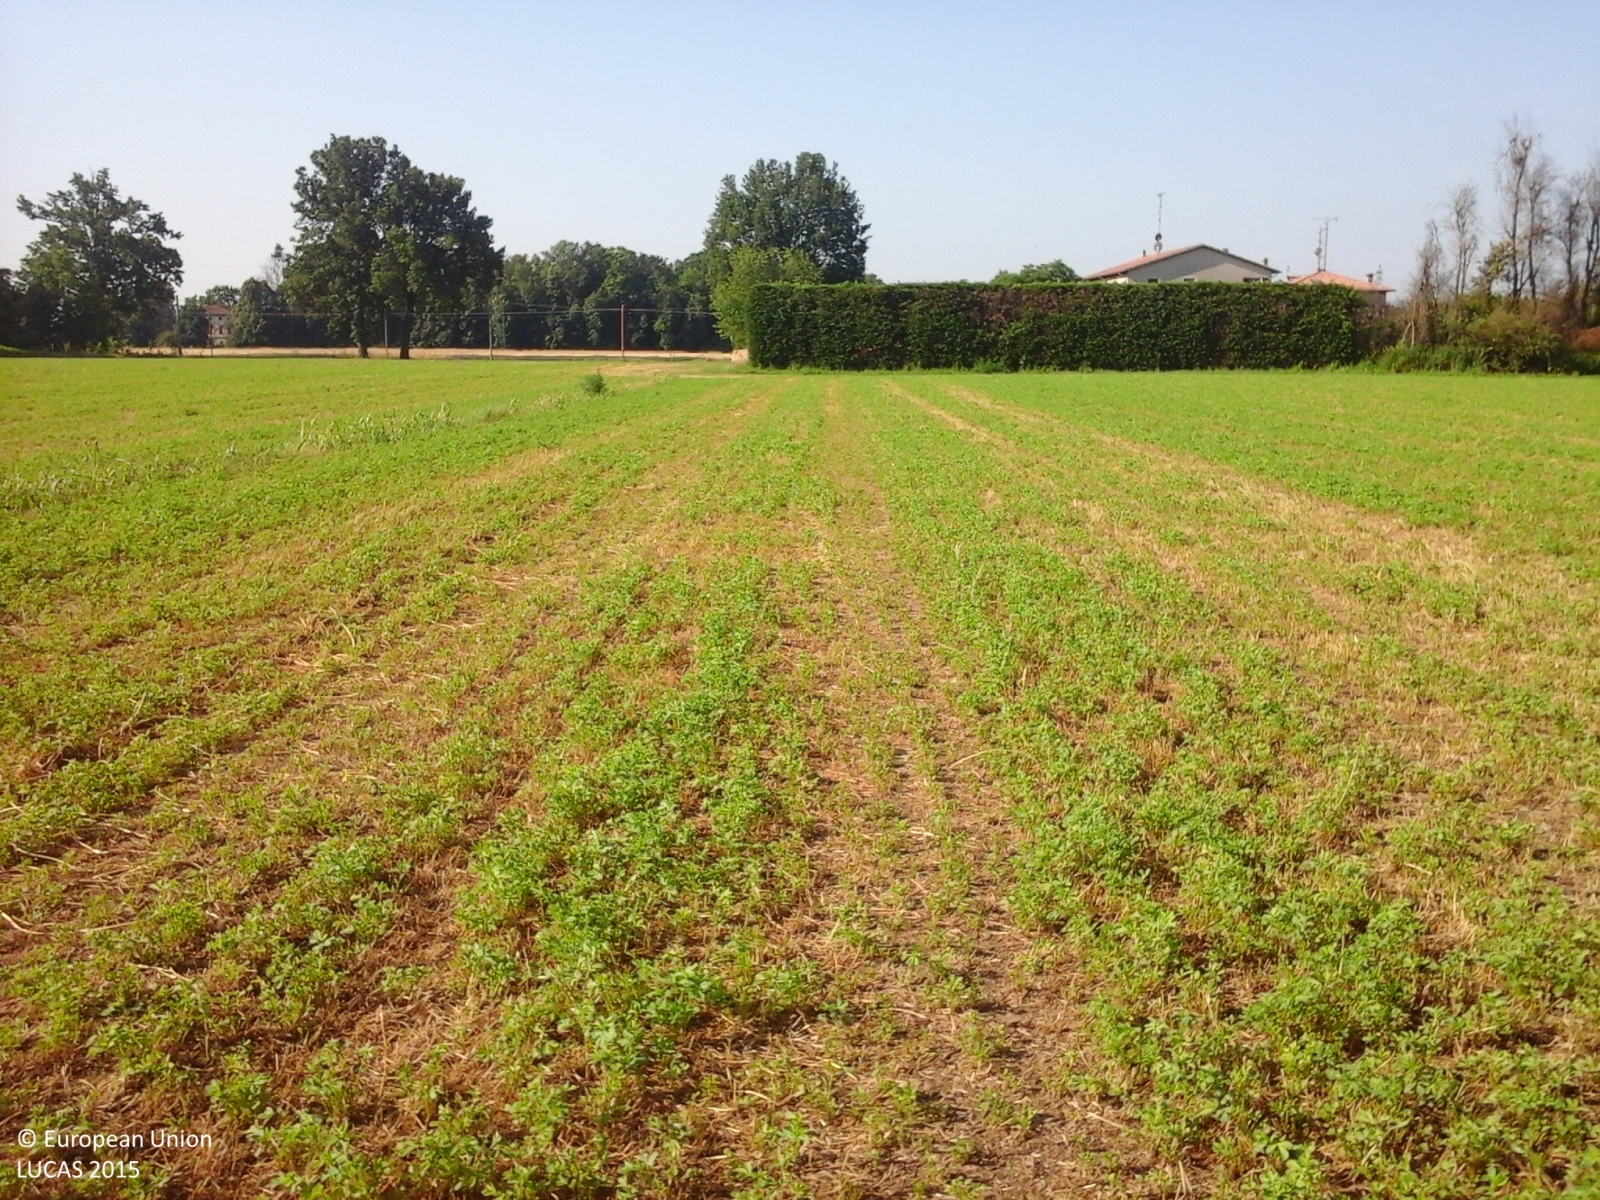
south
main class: Cropland
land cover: Lucerne
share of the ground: > 75 %
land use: Agriculture (excluding fallow land and kitchen gardens)
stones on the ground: < 10 %
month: June
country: IT
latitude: 44.5985
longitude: 10.9680
